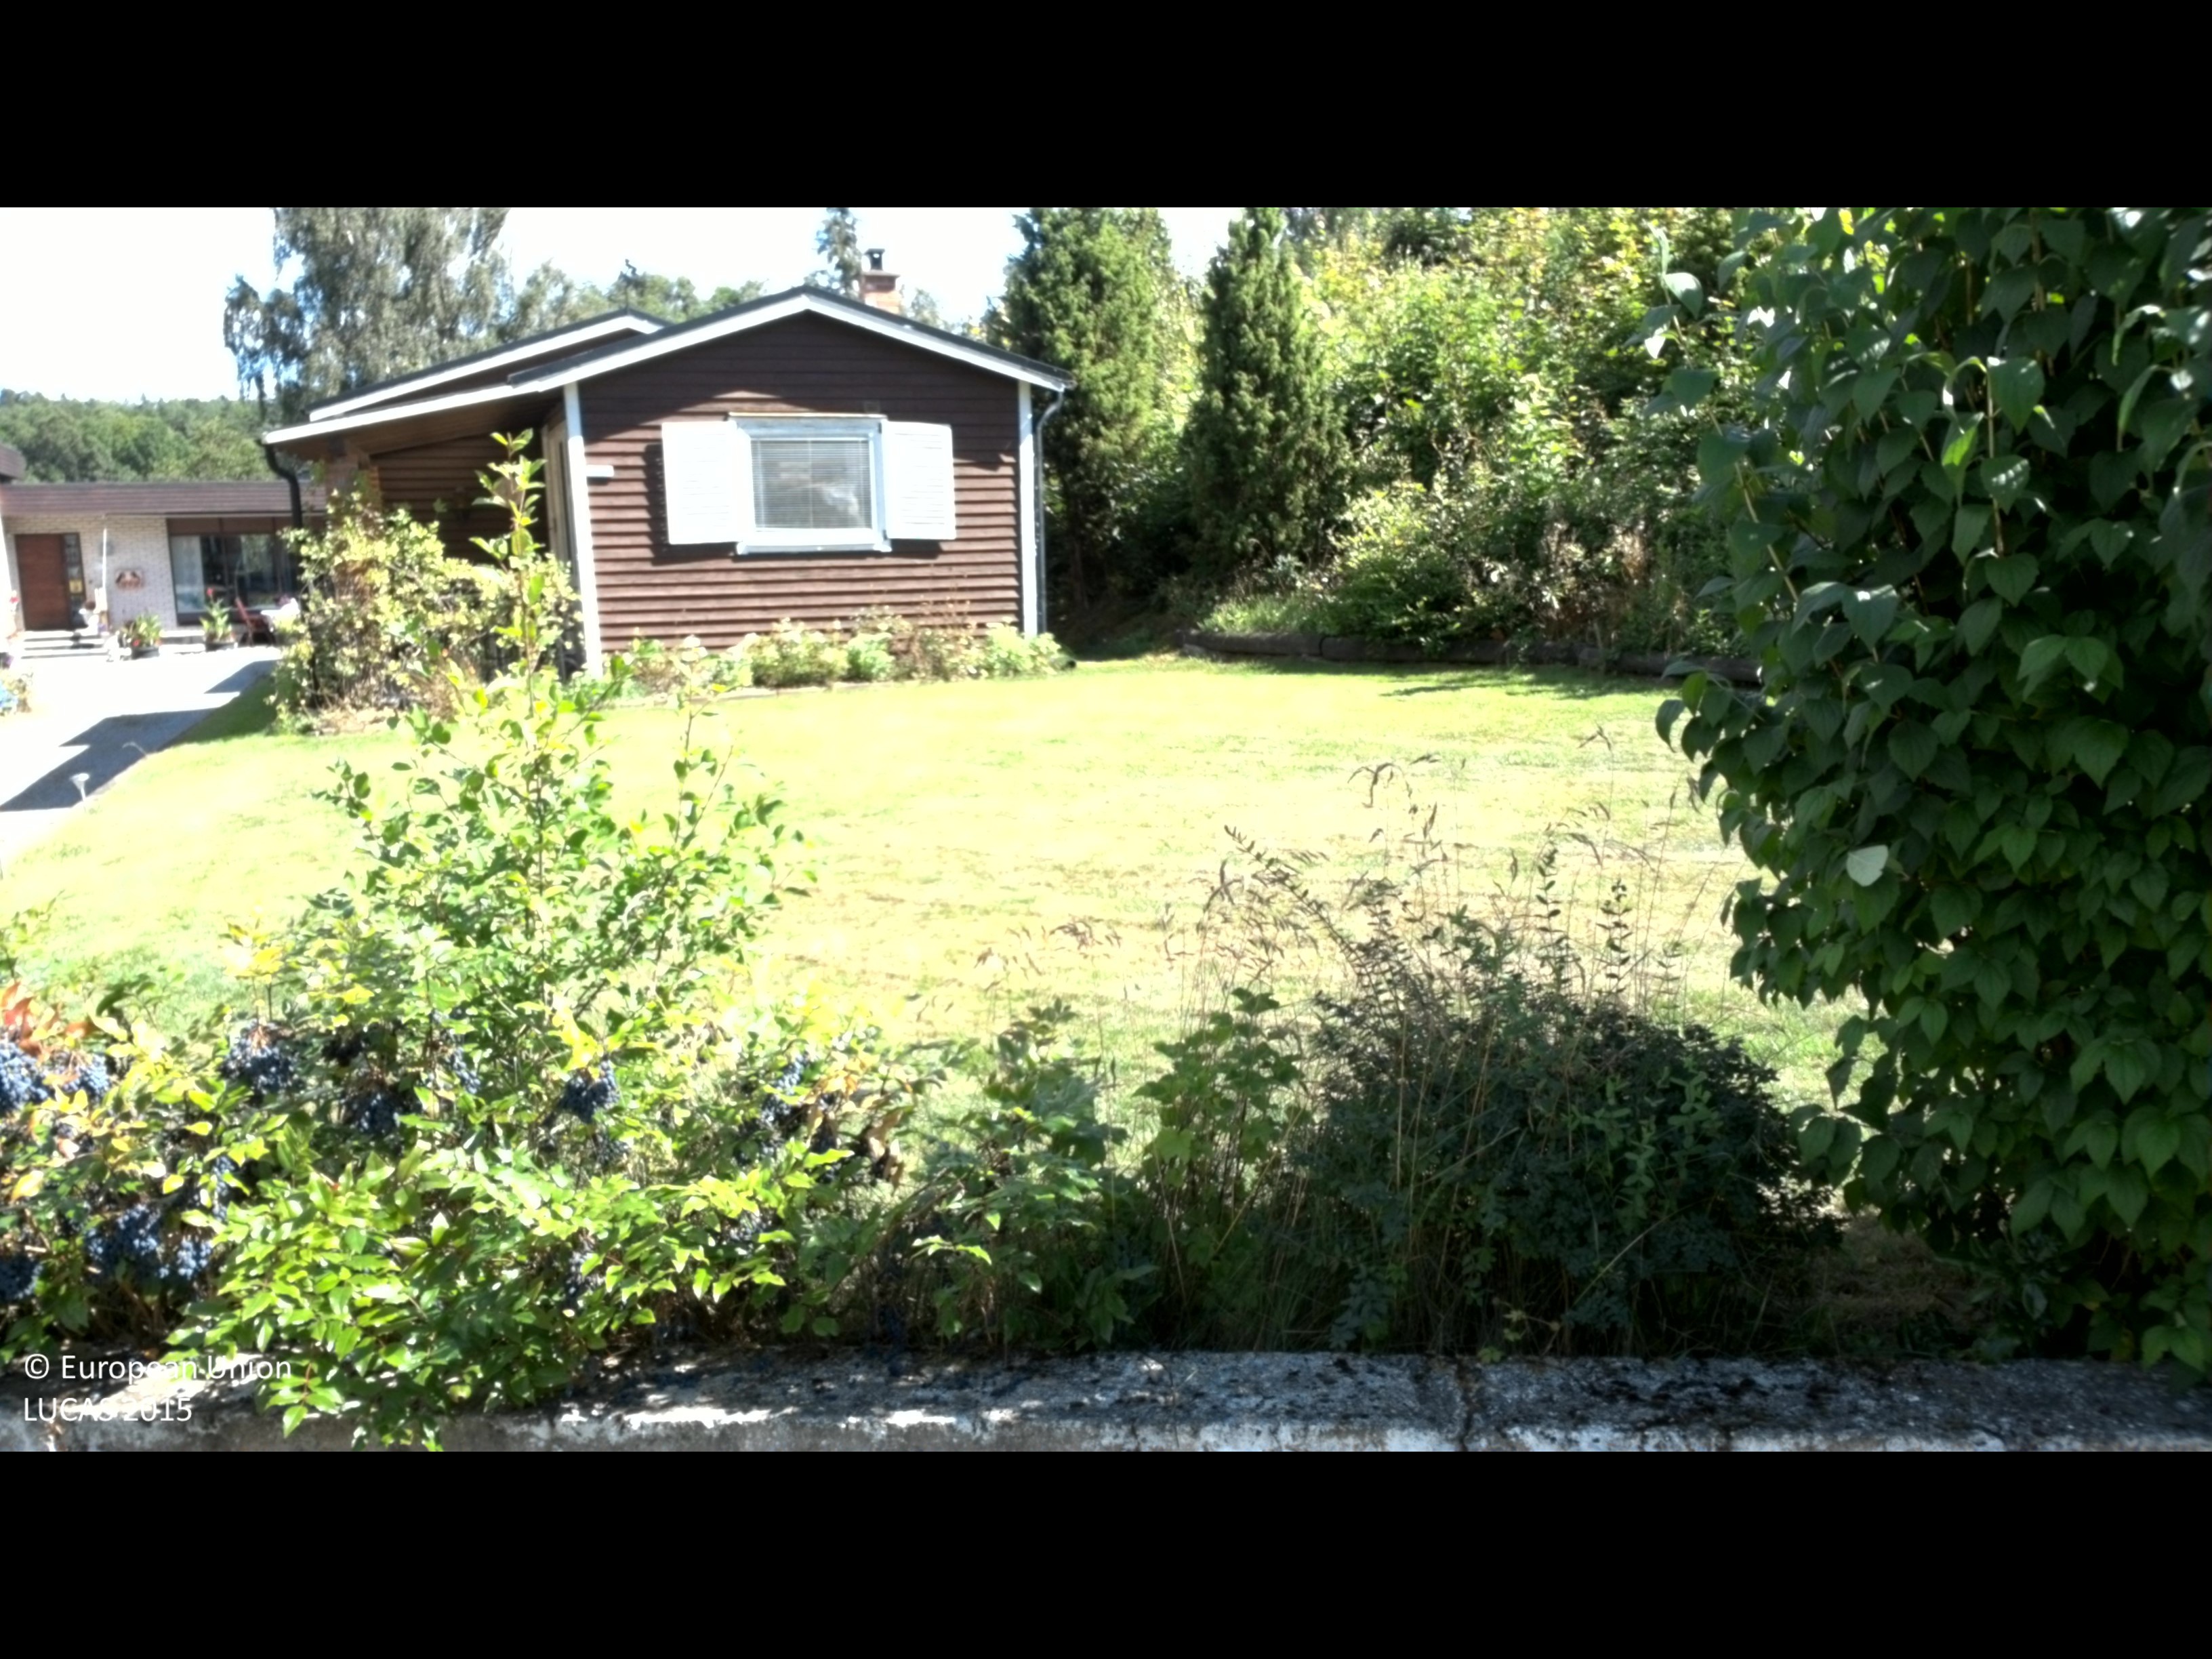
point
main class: Grassland
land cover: Grassland without tree/shrub cover
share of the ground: > 75 %
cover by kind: herbaceous plants 100 %
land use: Residential
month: August
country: SE
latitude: 56.2425
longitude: 14.7907
